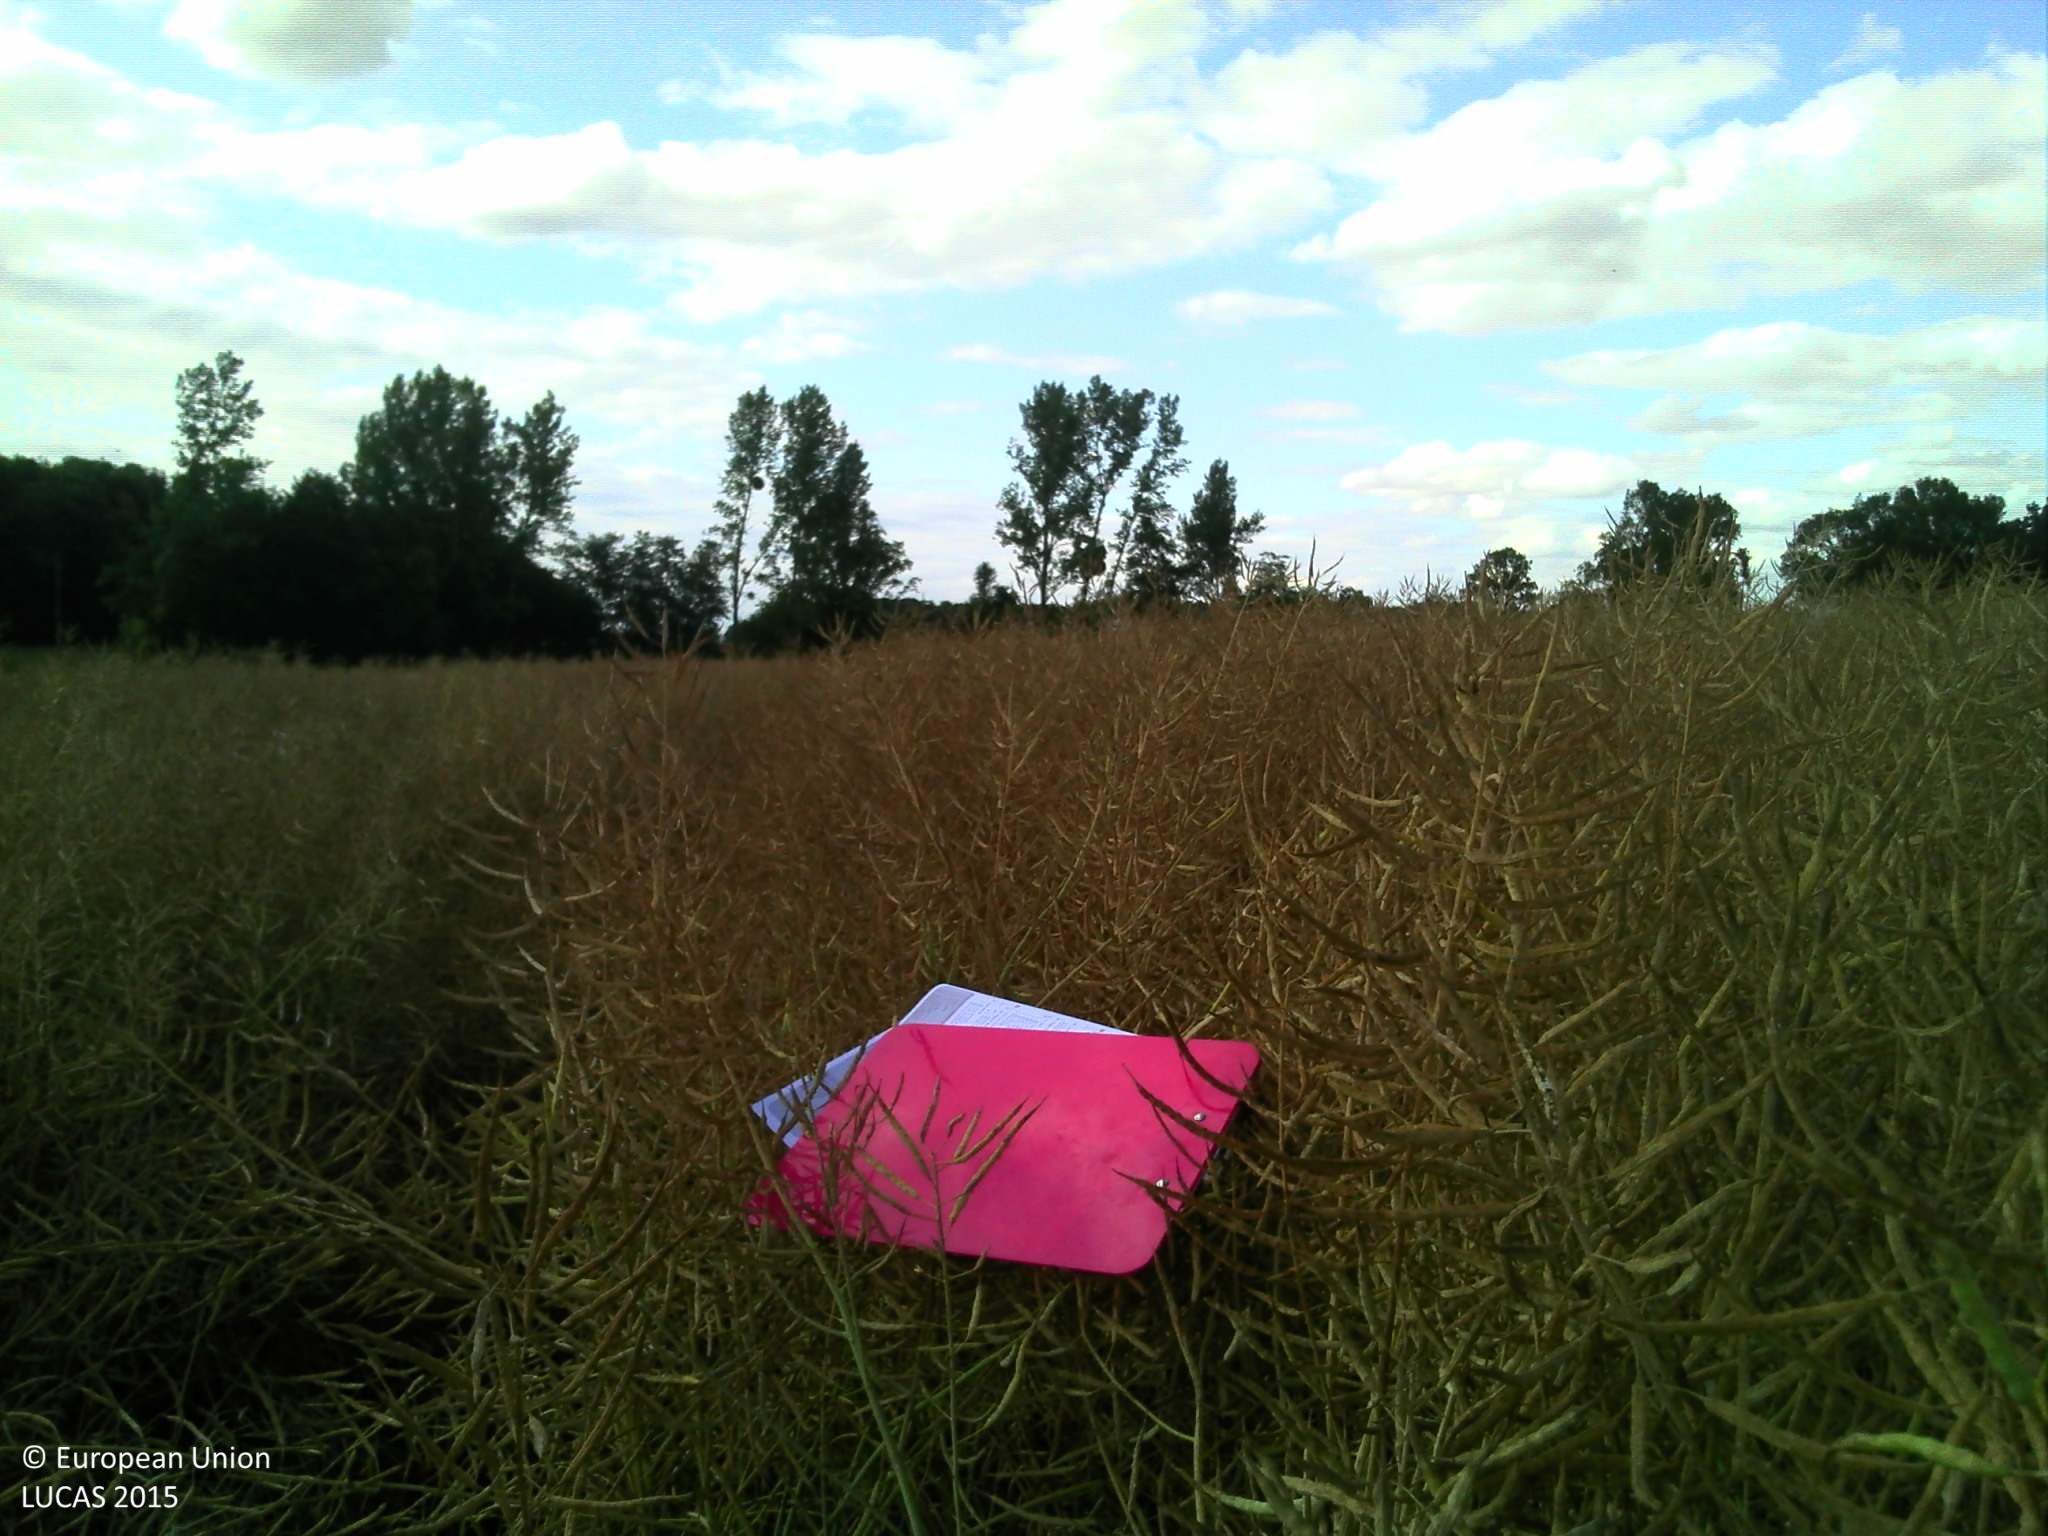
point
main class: Cropland
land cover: Rape and turnip rape
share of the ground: > 75 %
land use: Agriculture (excluding fallow land and kitchen gardens)
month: July
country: FR
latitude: 48.9628
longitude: 5.1220
